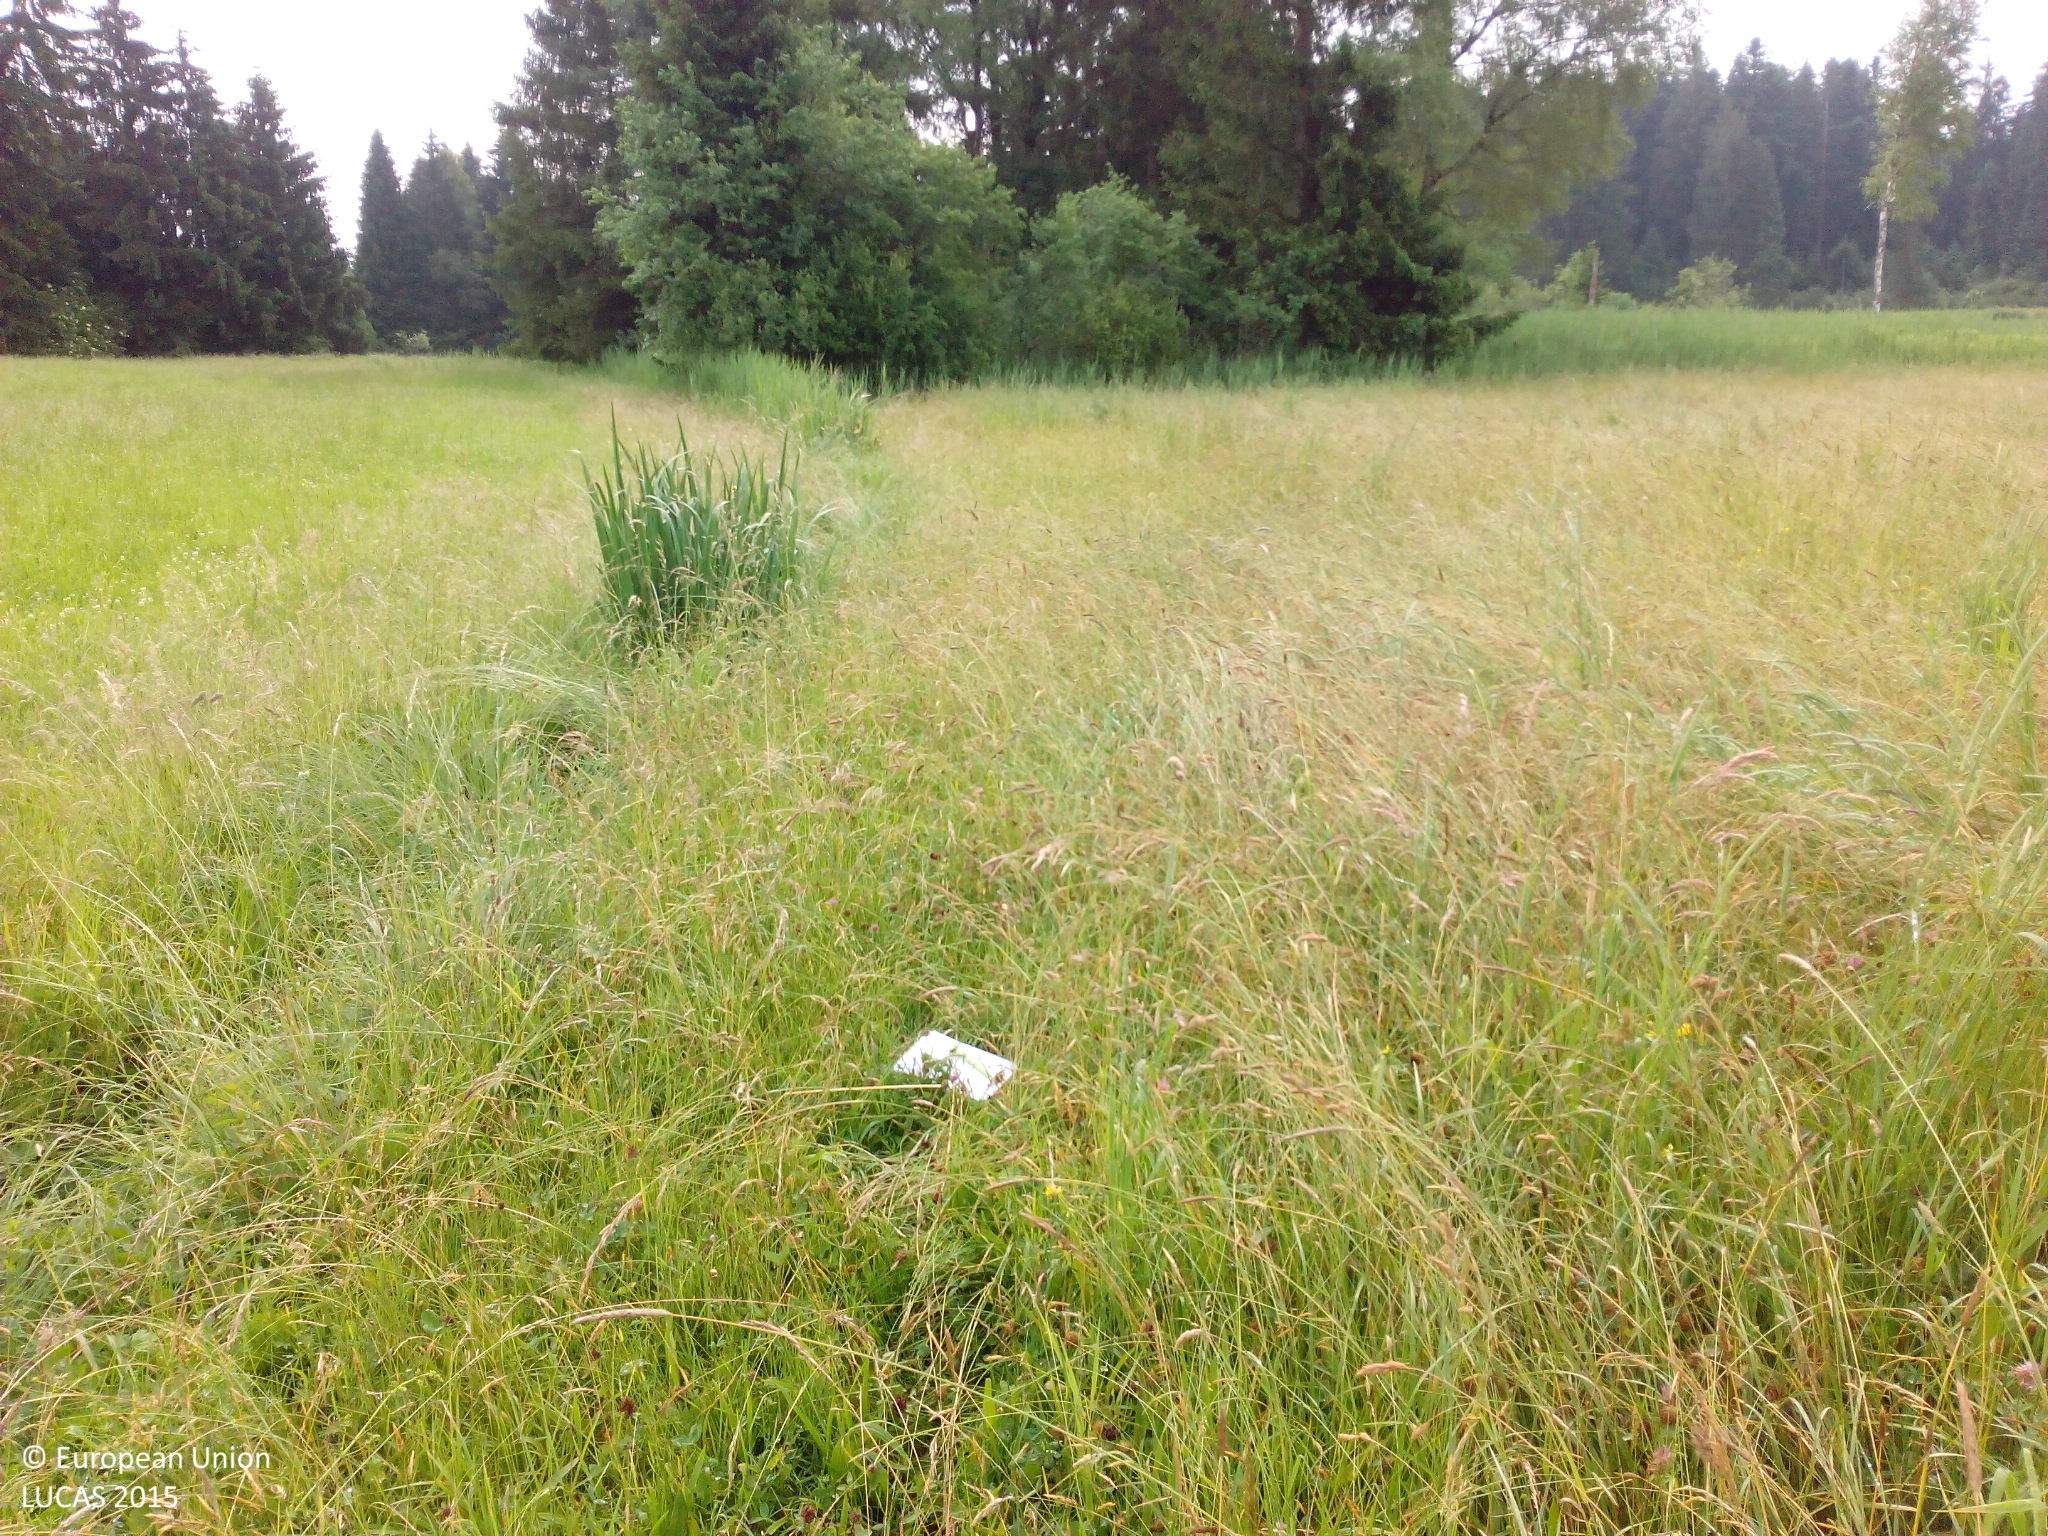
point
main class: Grassland
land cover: Grassland without tree/shrub cover
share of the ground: > 75 %
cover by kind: herbaceous plants 100 %
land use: Agriculture (excluding fallow land and kitchen gardens)
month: June
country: DE
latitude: 47.6296
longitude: 9.9335
